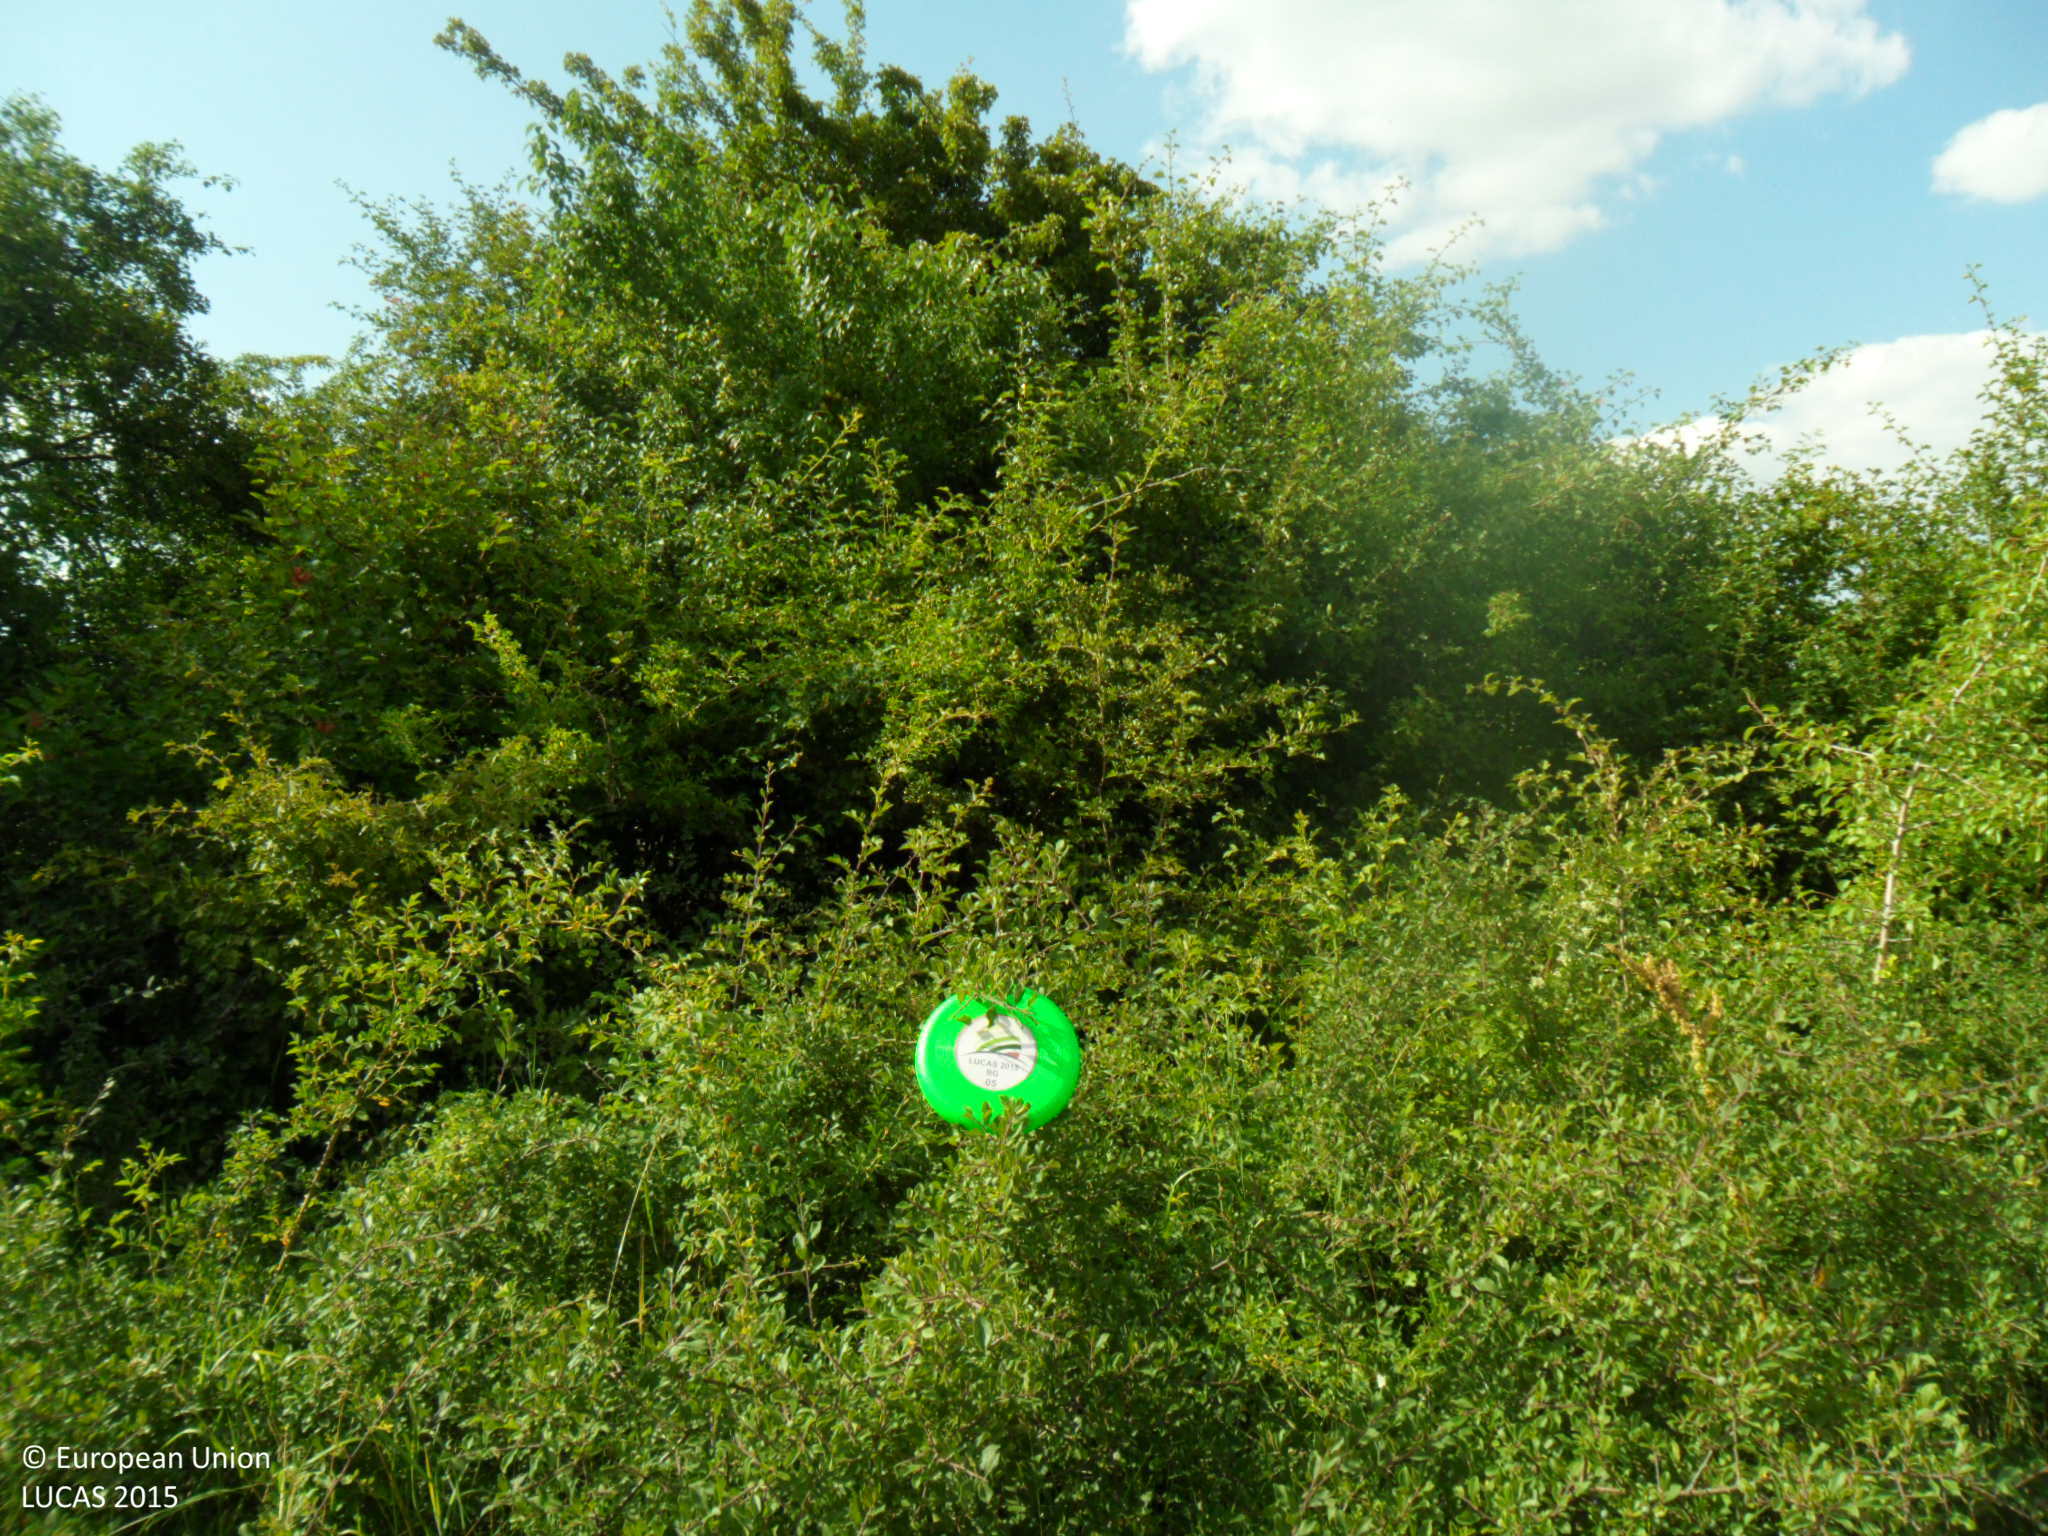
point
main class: Woodland
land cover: Broadleaved woodland
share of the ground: > 75 %
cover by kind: broadleaved forest trees 90 %, shrubs 10 %
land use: Semi-natural and natural areas not in use
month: June
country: BG
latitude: 43.4827
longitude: 26.9176
